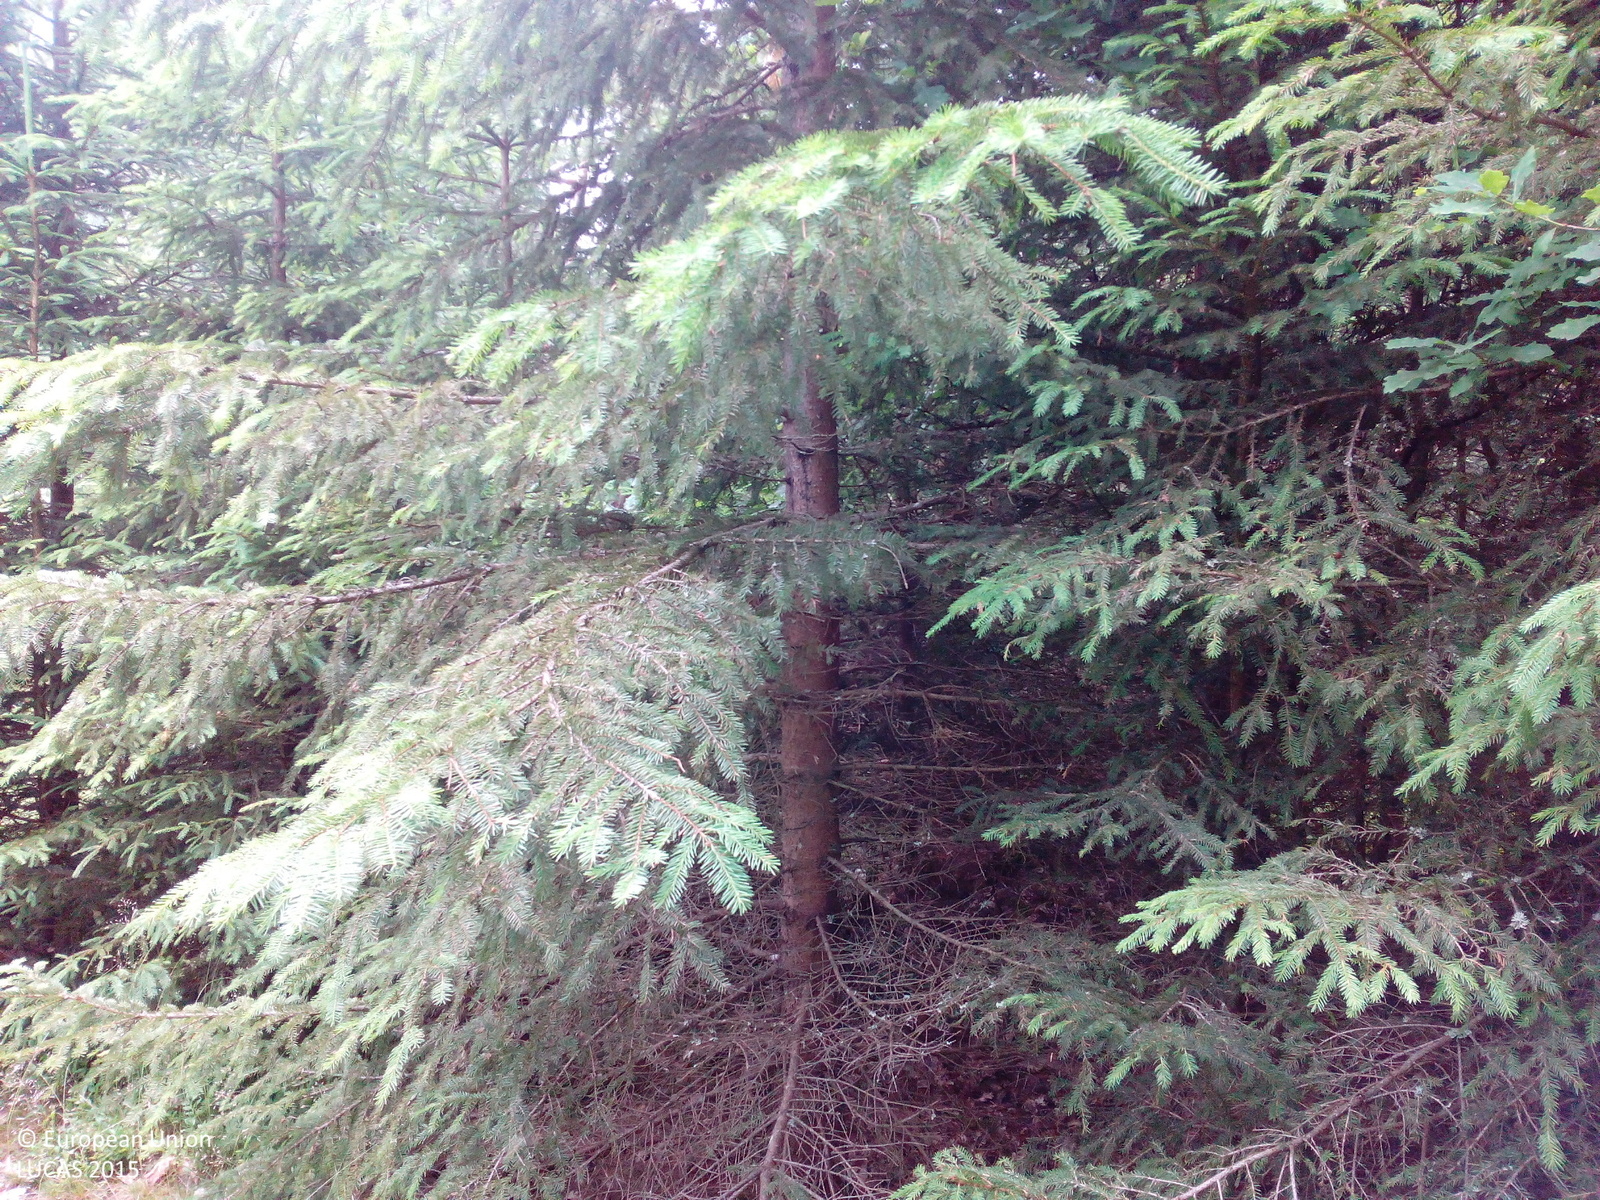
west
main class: Woodland
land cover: Spruce dominated mixed woodland
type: hemiboreal forest and nemoral coniferous forest and mixed broadleaved-coniferous forest
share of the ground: > 75 %
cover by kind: coniferous forest trees 60 %, broadleaved forest trees 25 %, herbaceous plants 15 %
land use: Forestry
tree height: < 5 m
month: July
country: DE
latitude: 49.7098
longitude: 12.3709
